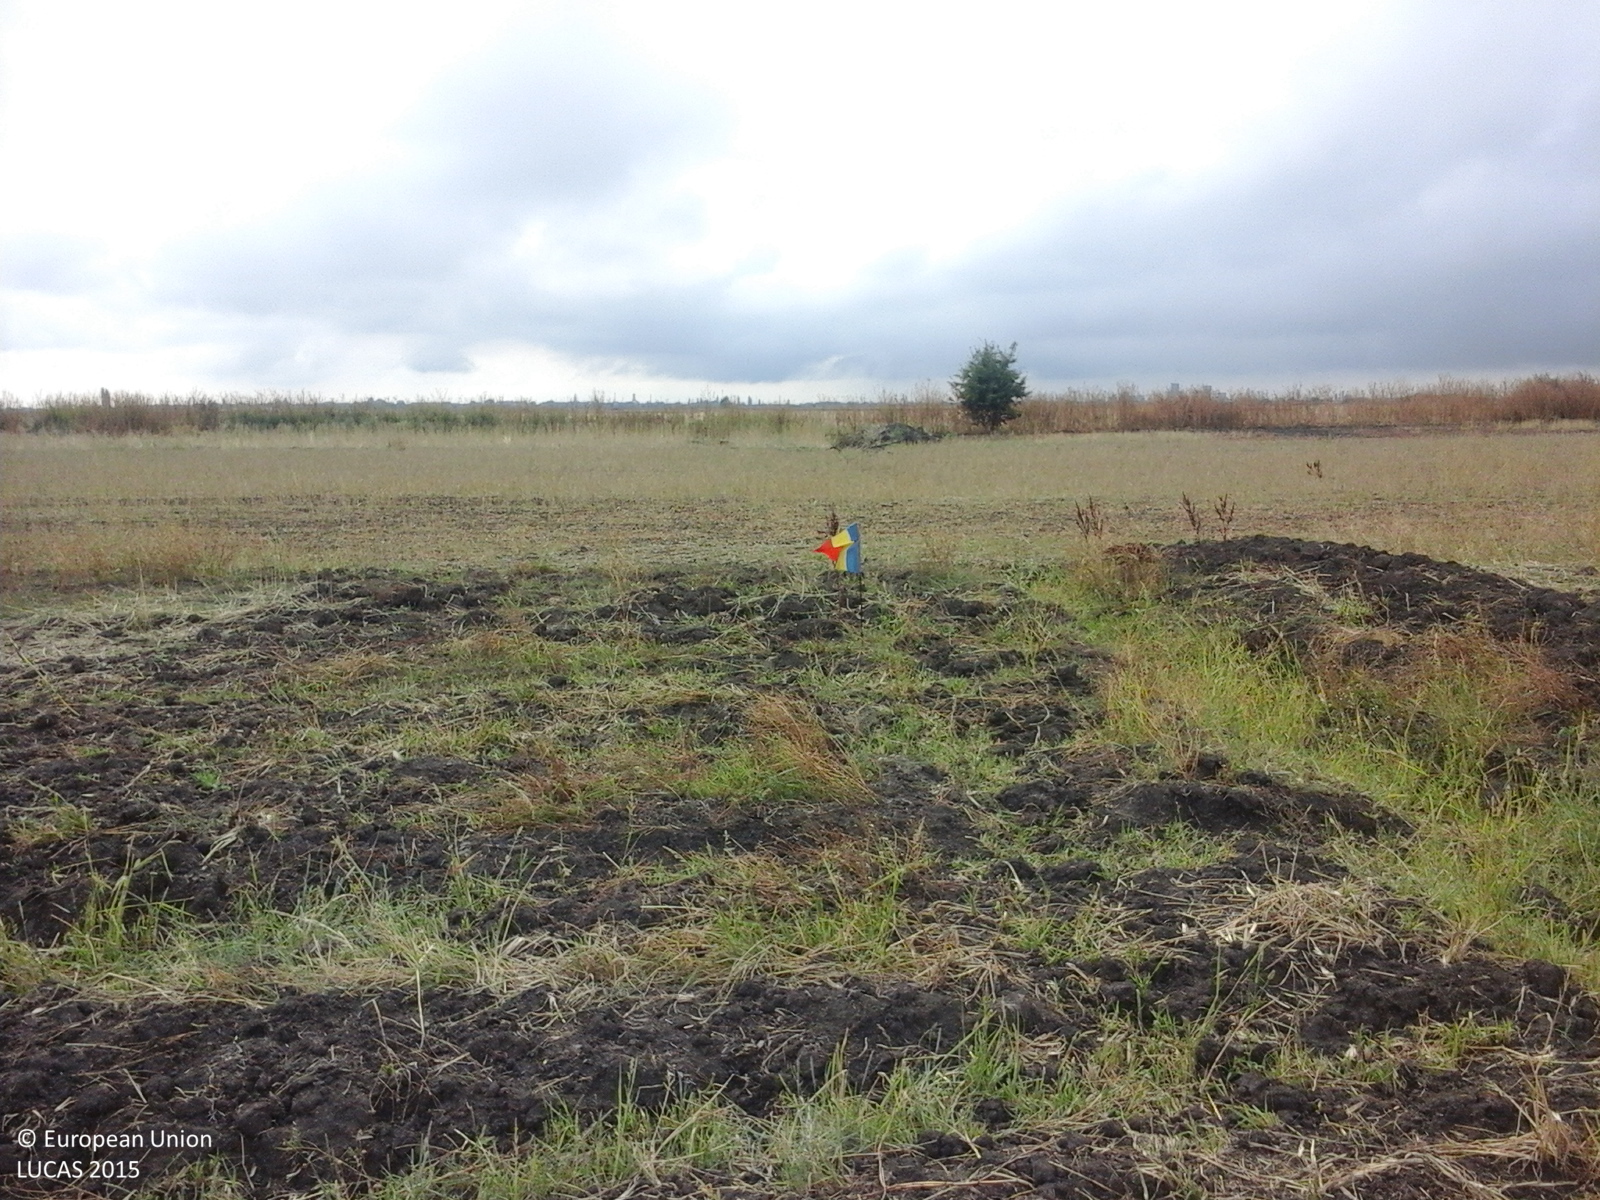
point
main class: Cropland
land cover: Common wheat
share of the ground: 10 - 25 %
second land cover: Spontaneously vegetated surfaces
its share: 25 - 50 %
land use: Agriculture (excluding fallow land and kitchen gardens)
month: August
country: RO
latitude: 46.0883
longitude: 20.6701
